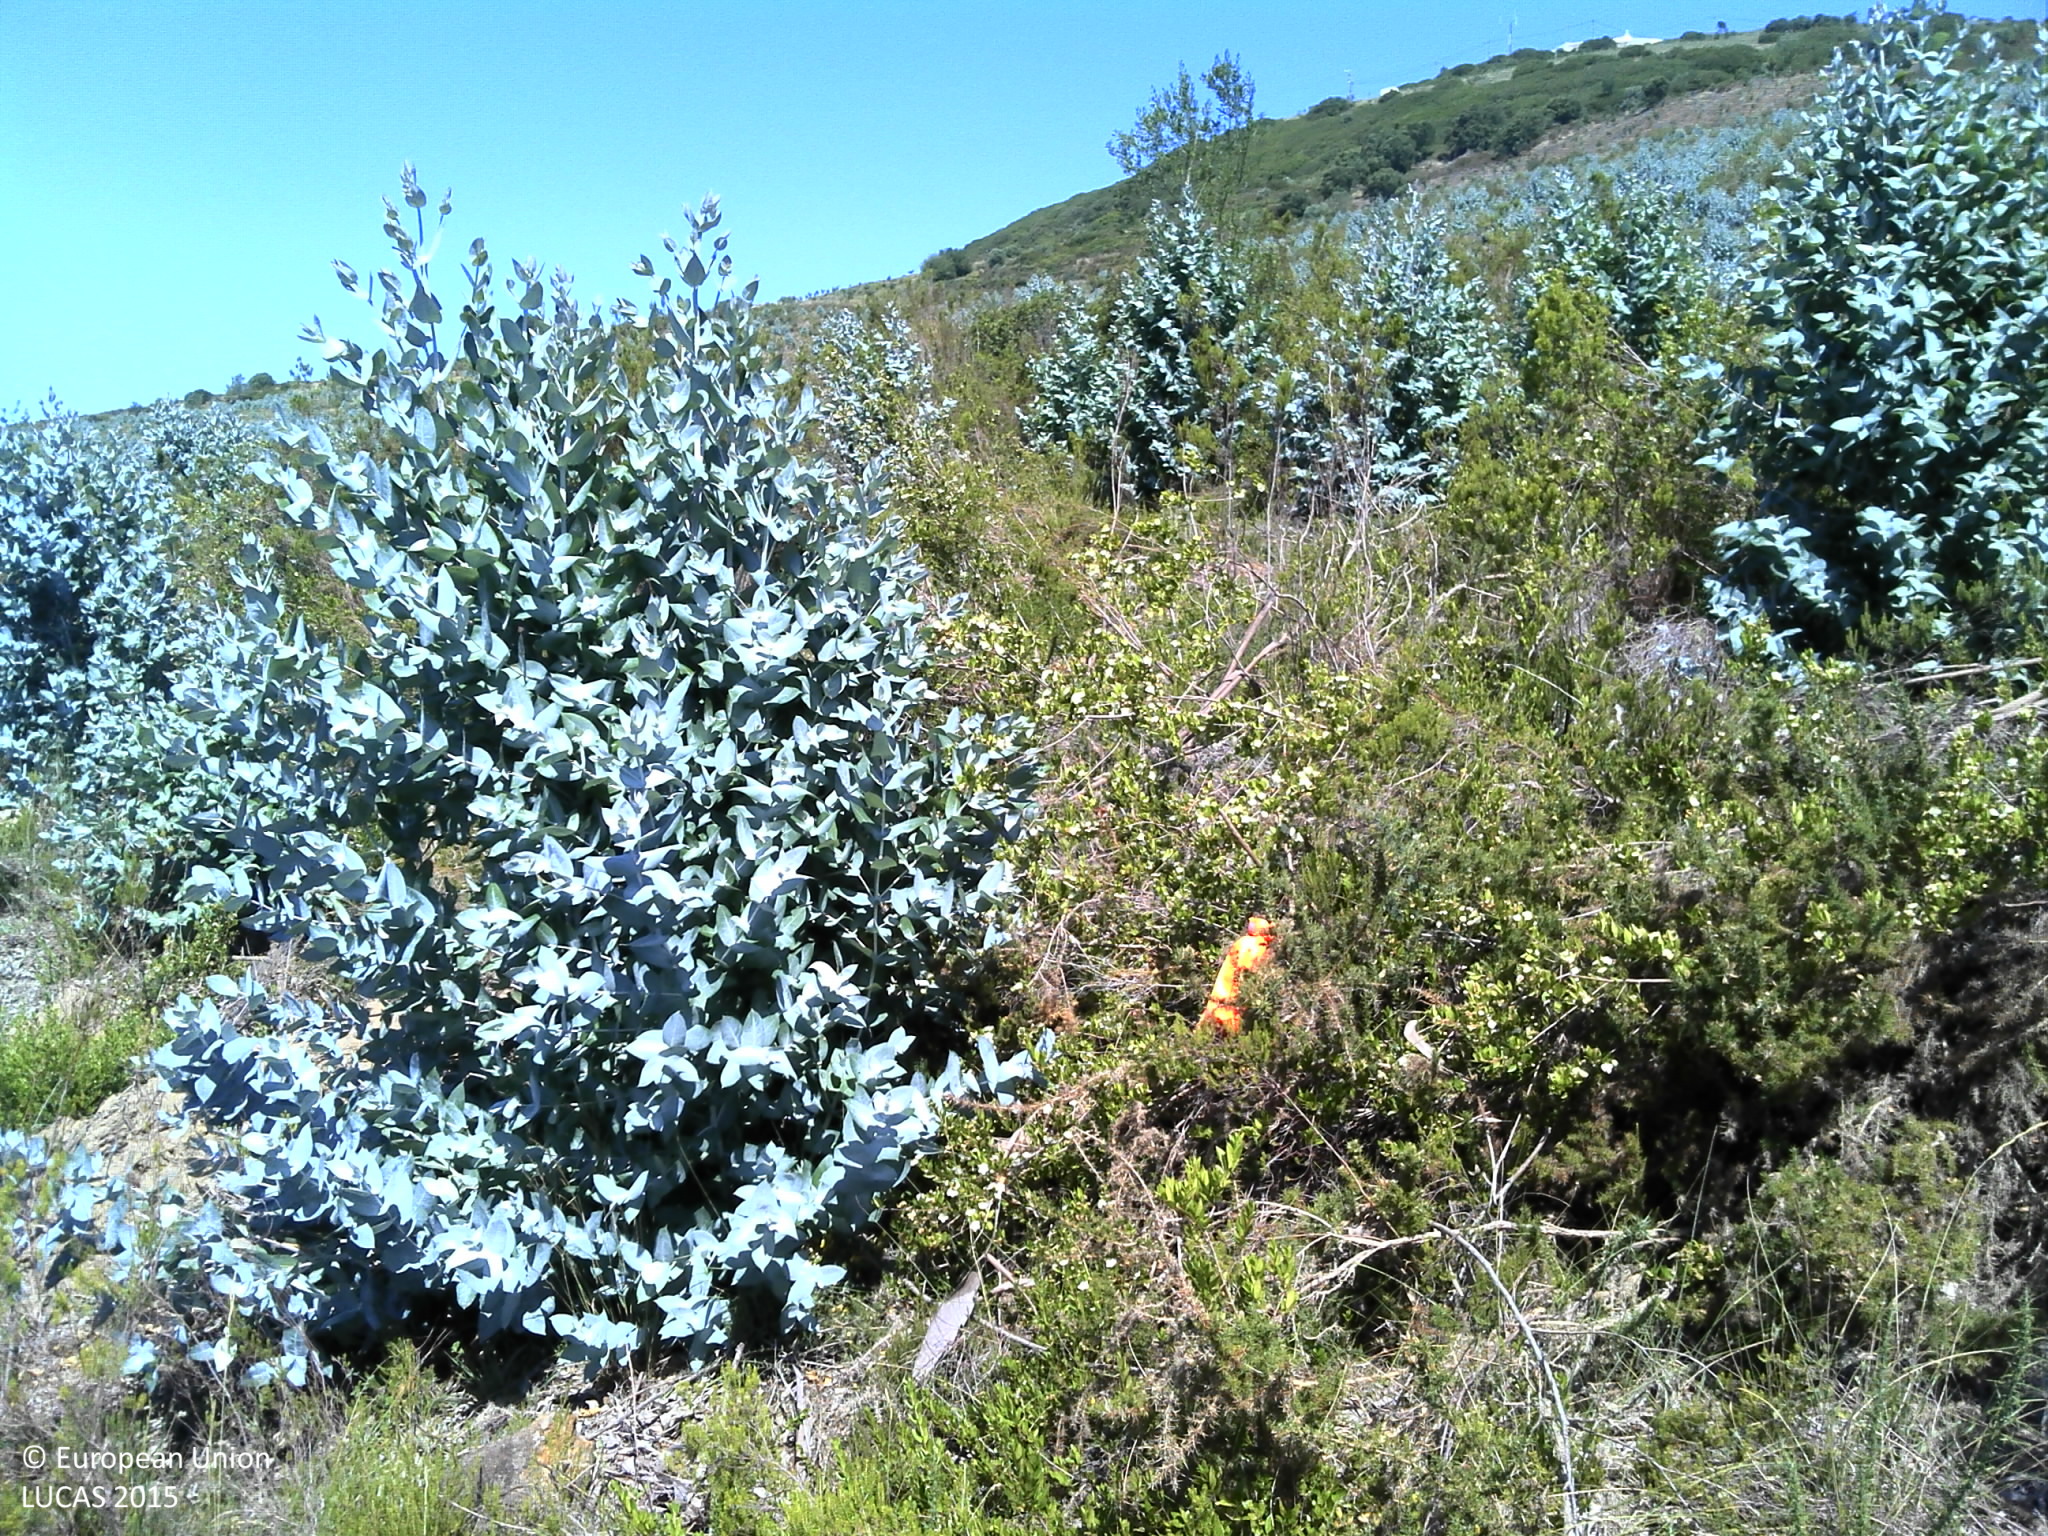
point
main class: Woodland
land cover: Broadleaved woodland
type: exotic forest
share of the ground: 10 - 25 %
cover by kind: shrubs 50 %, broadleaved forest trees 25 %, unconsolidated bare surface 25 %
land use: Forestry
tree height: < 5 m
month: June
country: PT
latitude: 39.0140
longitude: -9.2202
